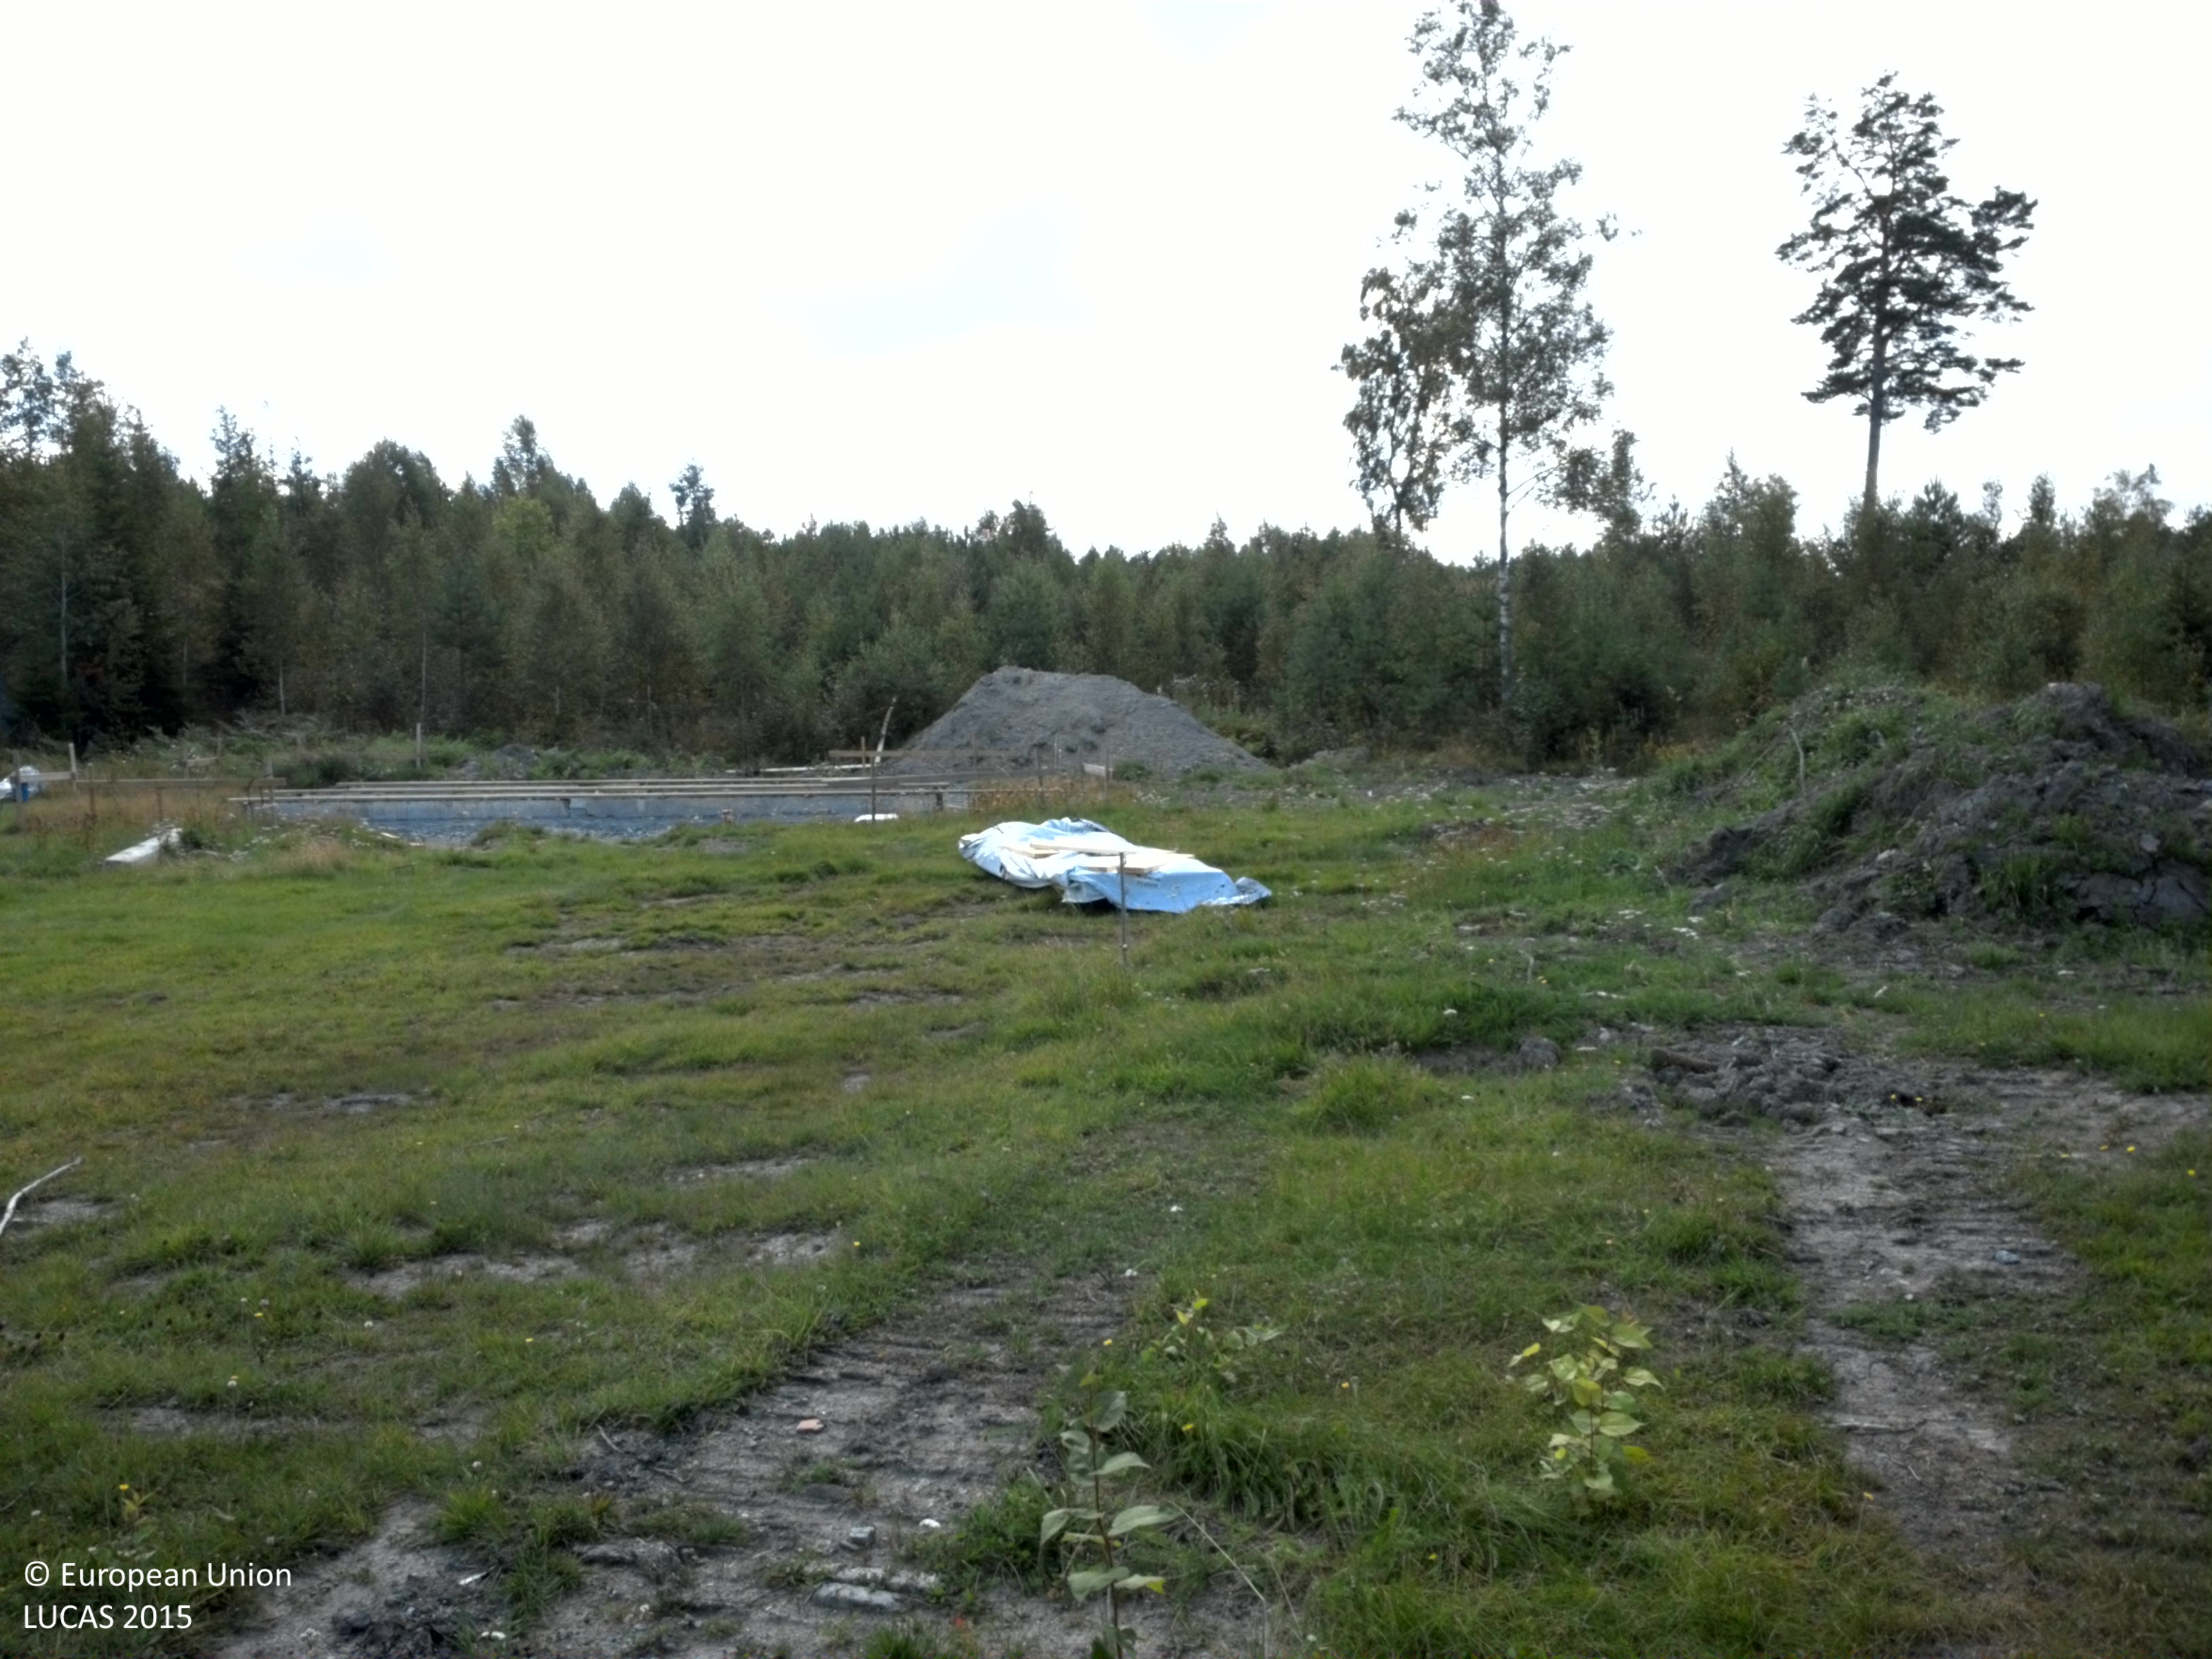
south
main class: Grassland
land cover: Grassland without tree/shrub cover
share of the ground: > 75 %
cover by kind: herbaceous plants 100 %
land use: Residential
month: August
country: SE
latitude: 59.6895
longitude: 17.8655
